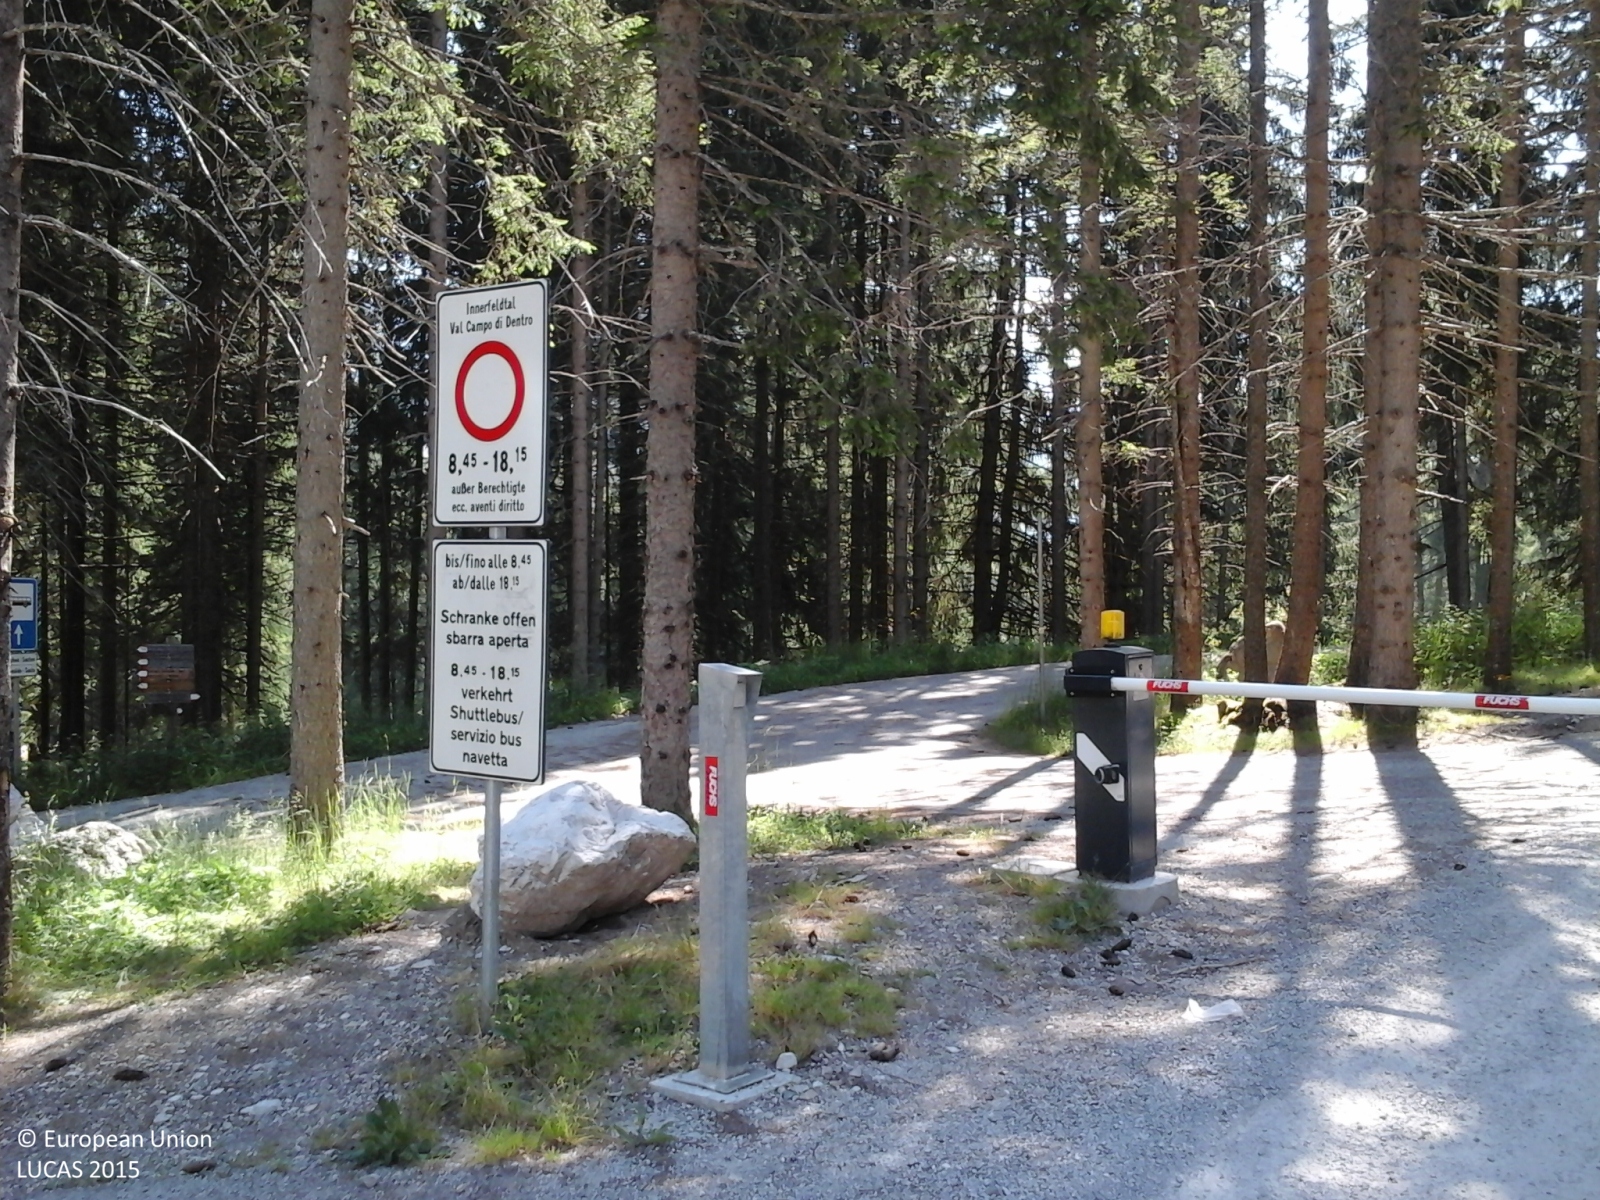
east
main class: Woodland
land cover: Spruce dominated coniferous woodland
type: alpine coniferous forest
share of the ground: > 75 %
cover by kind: coniferous forest trees 100 %
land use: Forestry
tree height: > 5 m
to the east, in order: Spruce dominated coniferous woodland; Tracks; Spruce dominated coniferous woodland; Rocks and stones; Rivers and streams; Other bare soil; Spruce dominated coniferous woodland
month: July
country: IT
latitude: 46.6866
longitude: 12.3119
